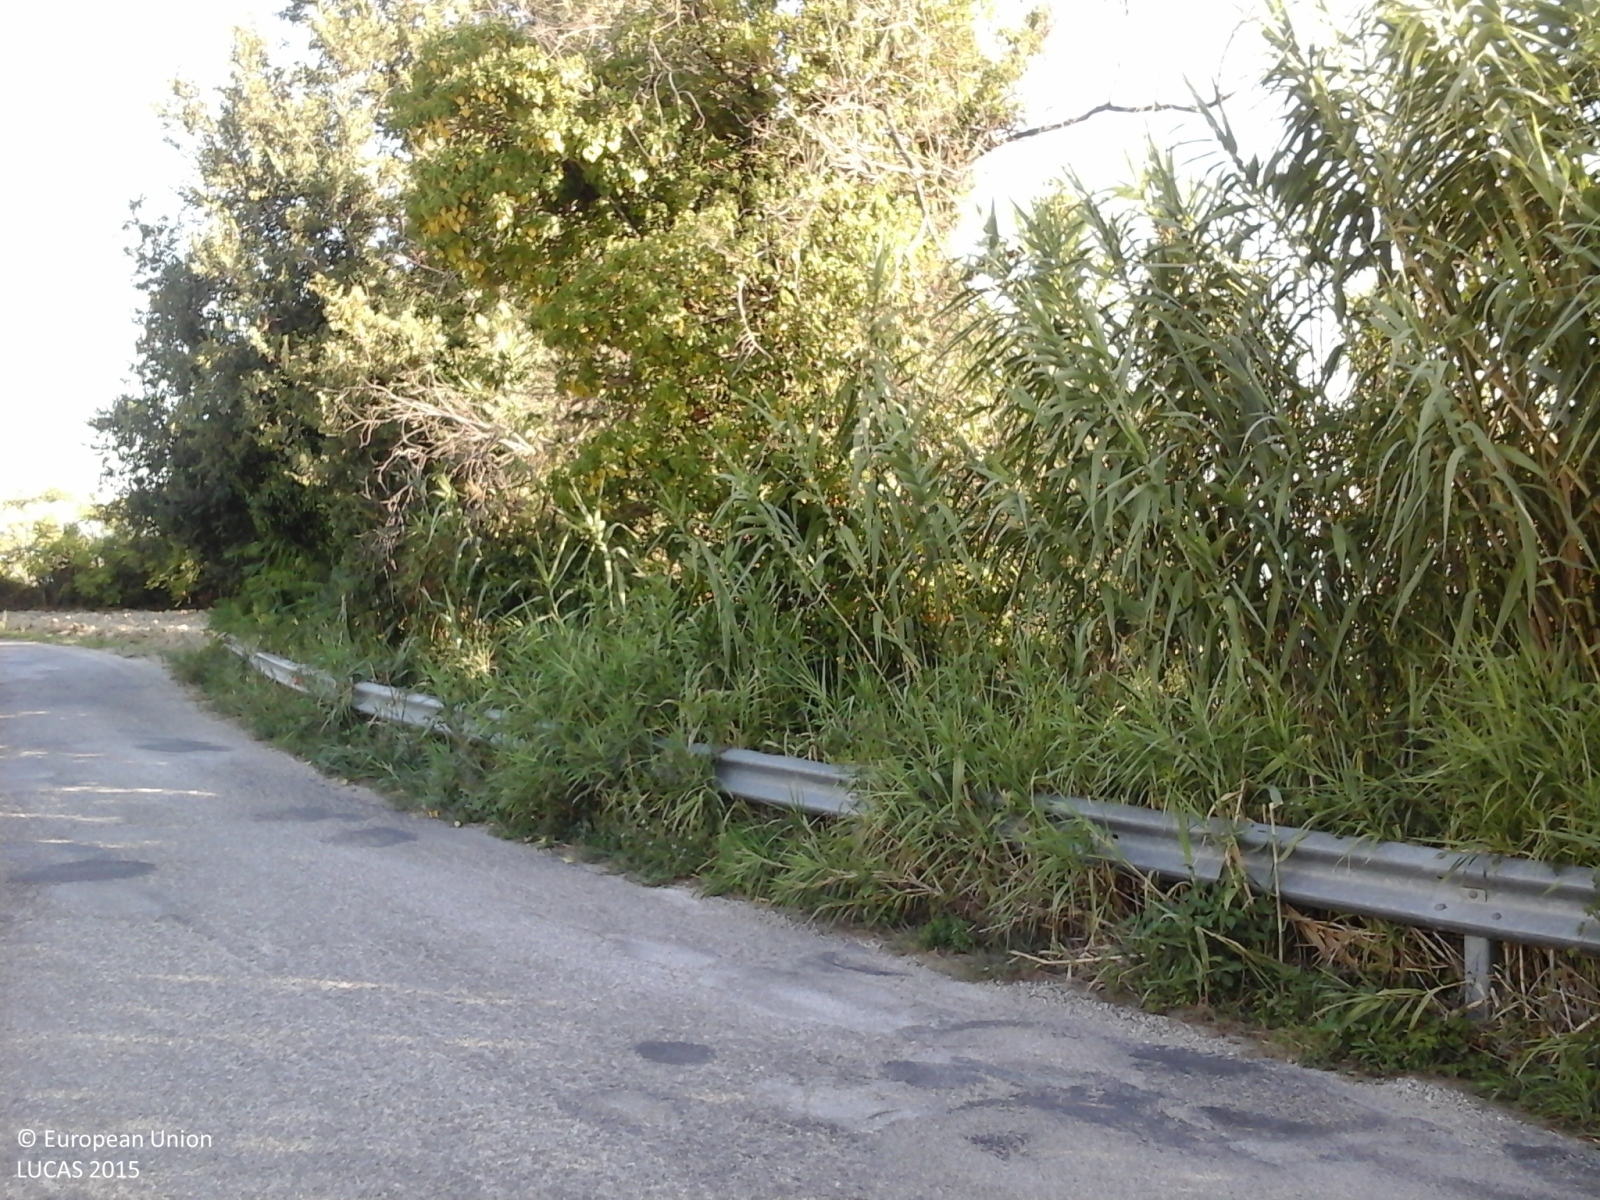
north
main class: Cropland
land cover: Durum wheat
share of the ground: < 10 %
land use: Agriculture (excluding fallow land and kitchen gardens)
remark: Harvested field
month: September
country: IT
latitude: 43.8749
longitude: 12.9674
